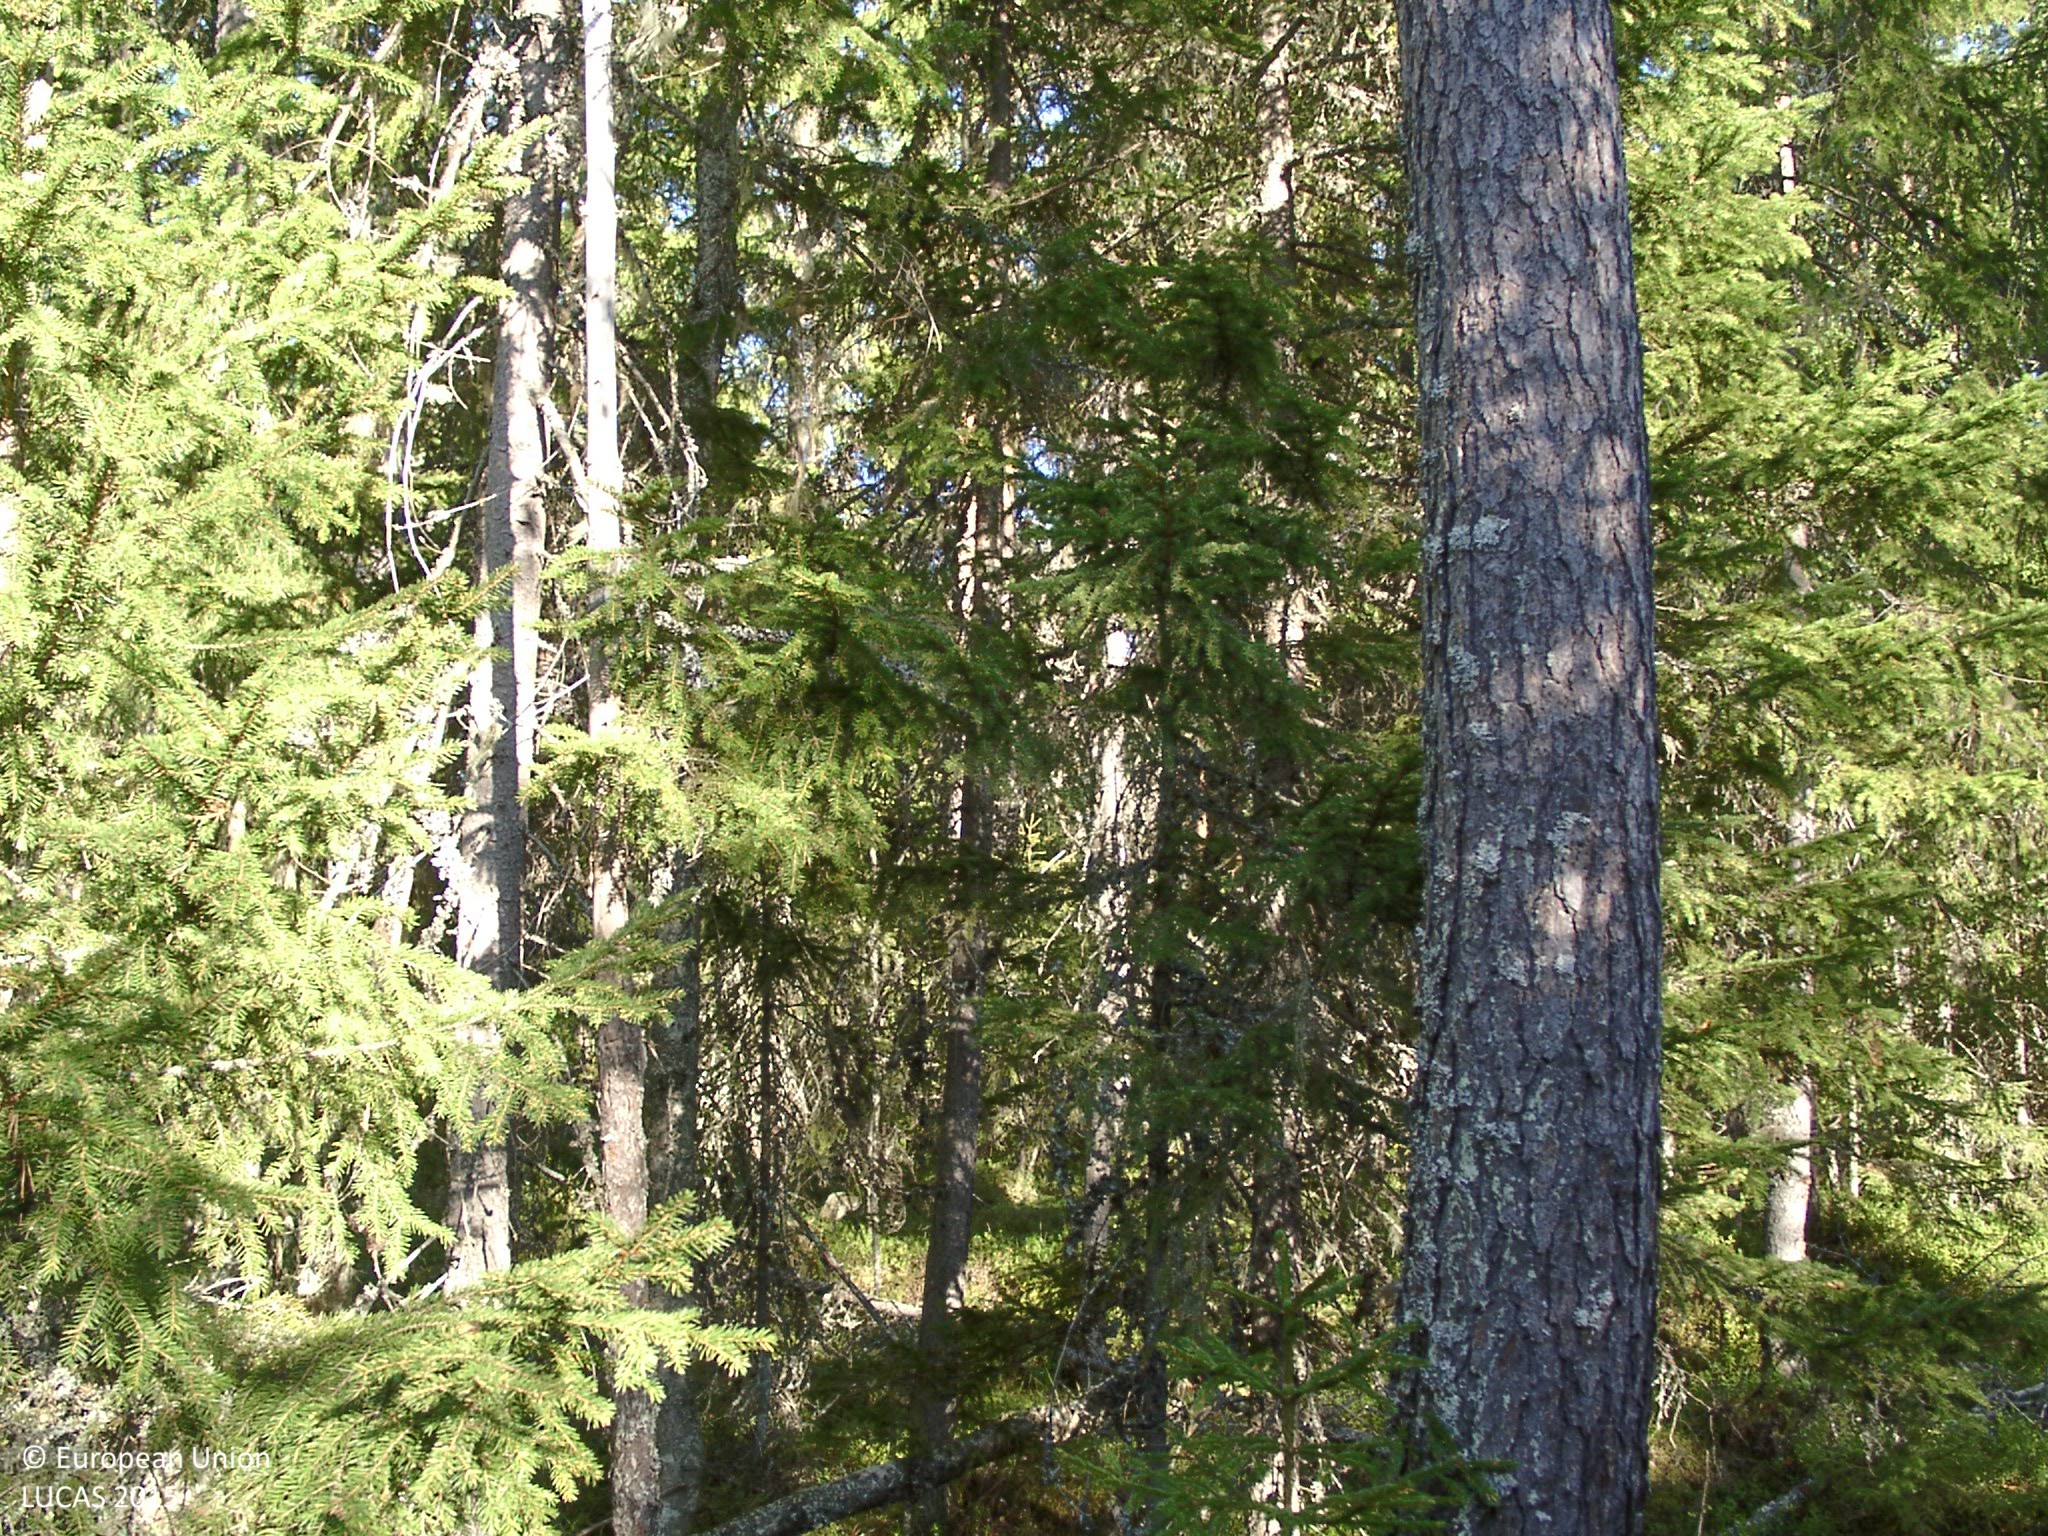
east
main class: Woodland
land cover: Other mixed woodland
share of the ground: 50 - 75 %
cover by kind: coniferous forest trees 50 %, broadleaved forest trees 20 %, shrubs 20 %, herbaceous plants 5 %, lichens and mosses 5 %
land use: Forestry
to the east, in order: Other mixed woodland; Shruby margins; Other coniferous woodland; Ditches and canals; Other coniferous woodland; Shruby margins; Other mixed woodland; Ditches and canals; Spruce dominated mixed woodland; Grass margins; Other mixed woodland; Shrubland with sparse tree cover; Other coniferous woodland; Grass margins; Broadleaved woodland; Ditches and canals; Shruby margins; Other coniferous woodland
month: August
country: FI
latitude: 61.9978
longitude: 24.8603
